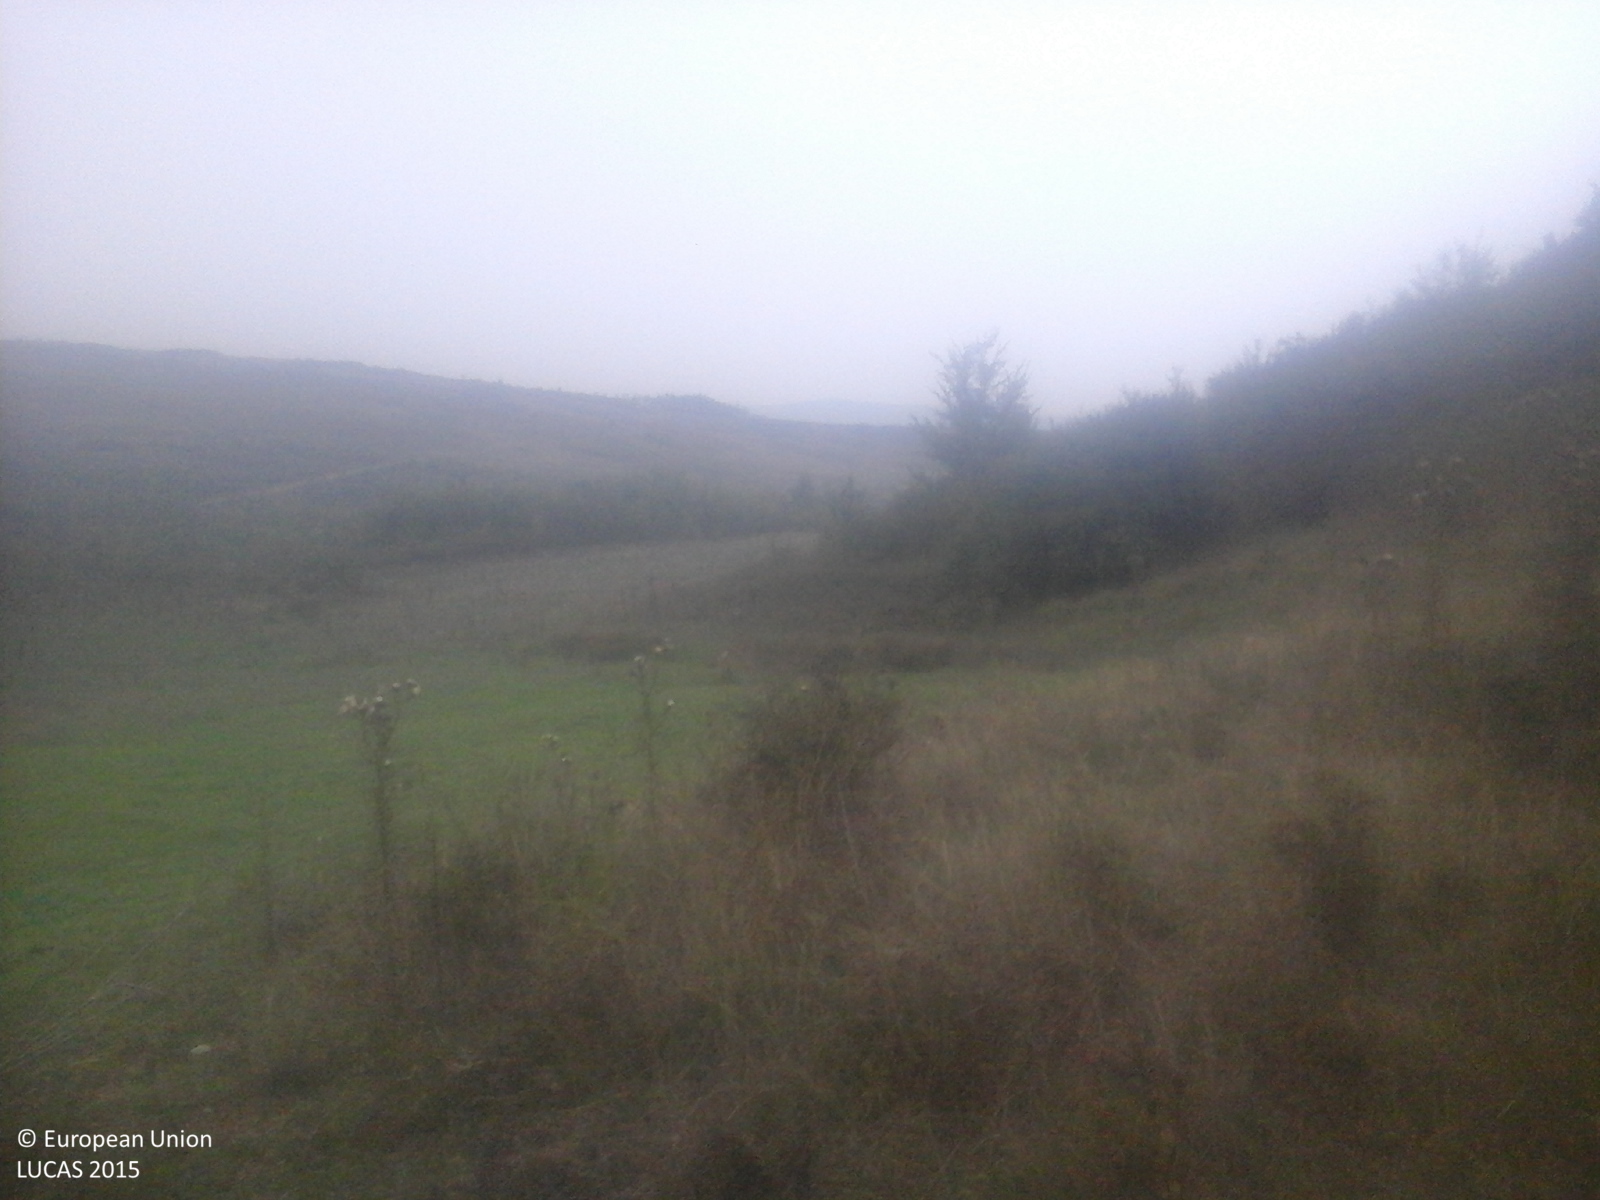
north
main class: Shrubland
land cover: Shrubland without tree cover
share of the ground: > 75 %
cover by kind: shrubs 100 %
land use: Semi-natural and natural areas not in use
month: September
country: RO
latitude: 44.6723
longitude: 23.3348
